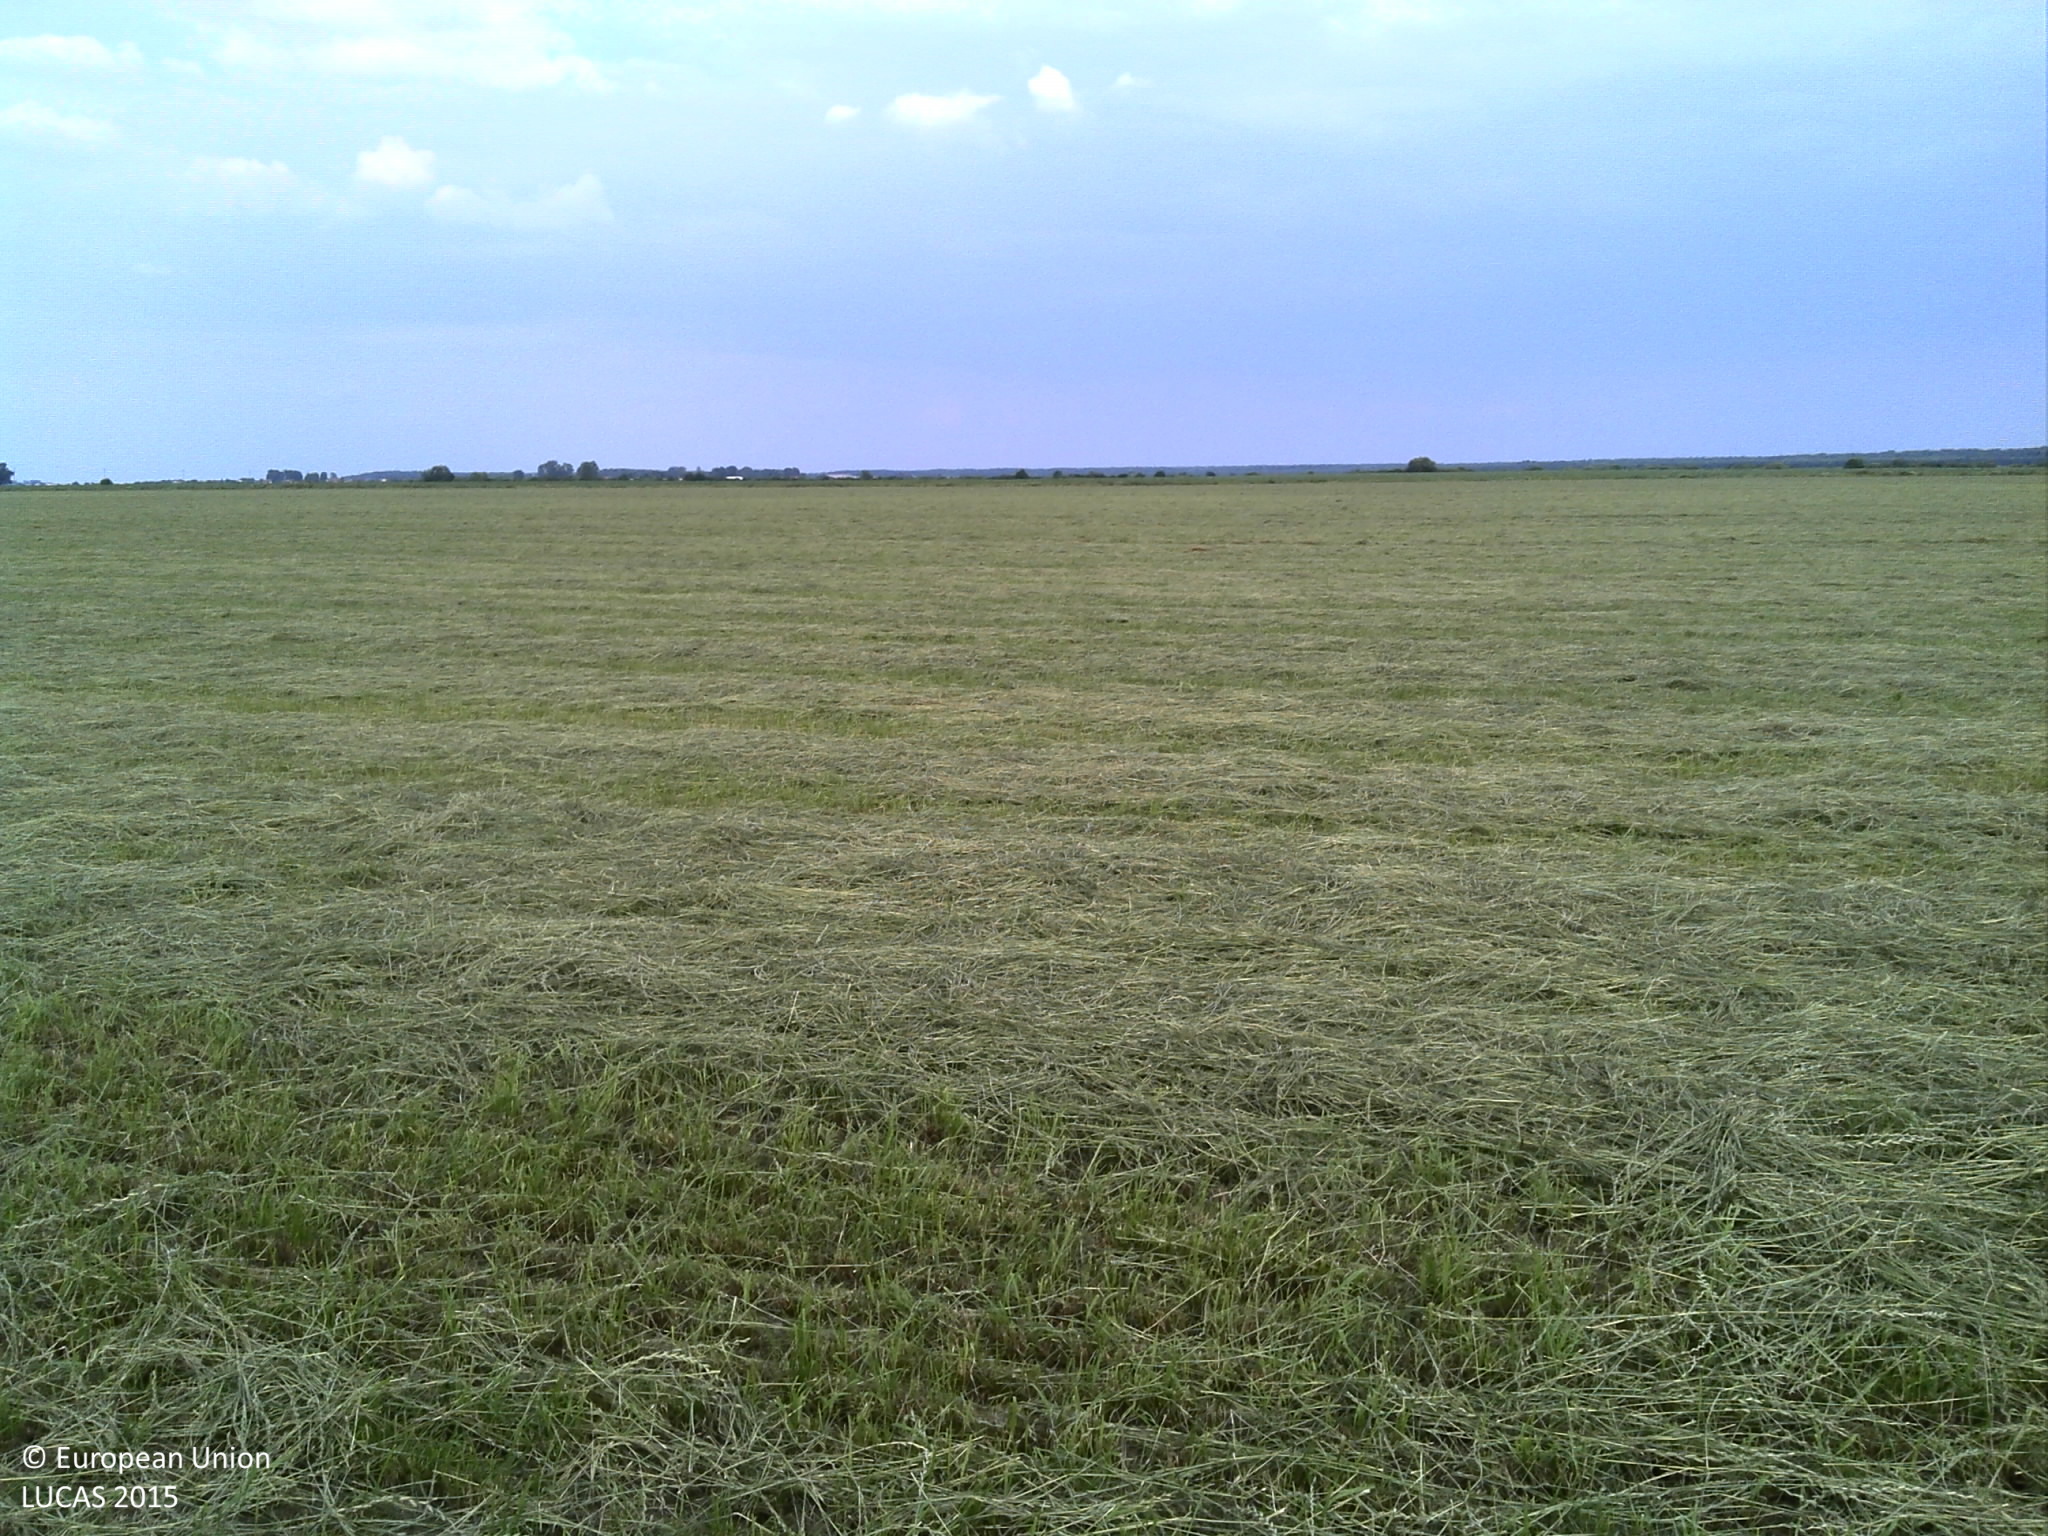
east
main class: Grassland
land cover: Grassland without tree/shrub cover
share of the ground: > 75 %
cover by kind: herbaceous plants 100 %
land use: Agriculture (excluding fallow land and kitchen gardens)
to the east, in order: Grassland without tree/shrub cover
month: June
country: HR
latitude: 45.4027
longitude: 18.4247
